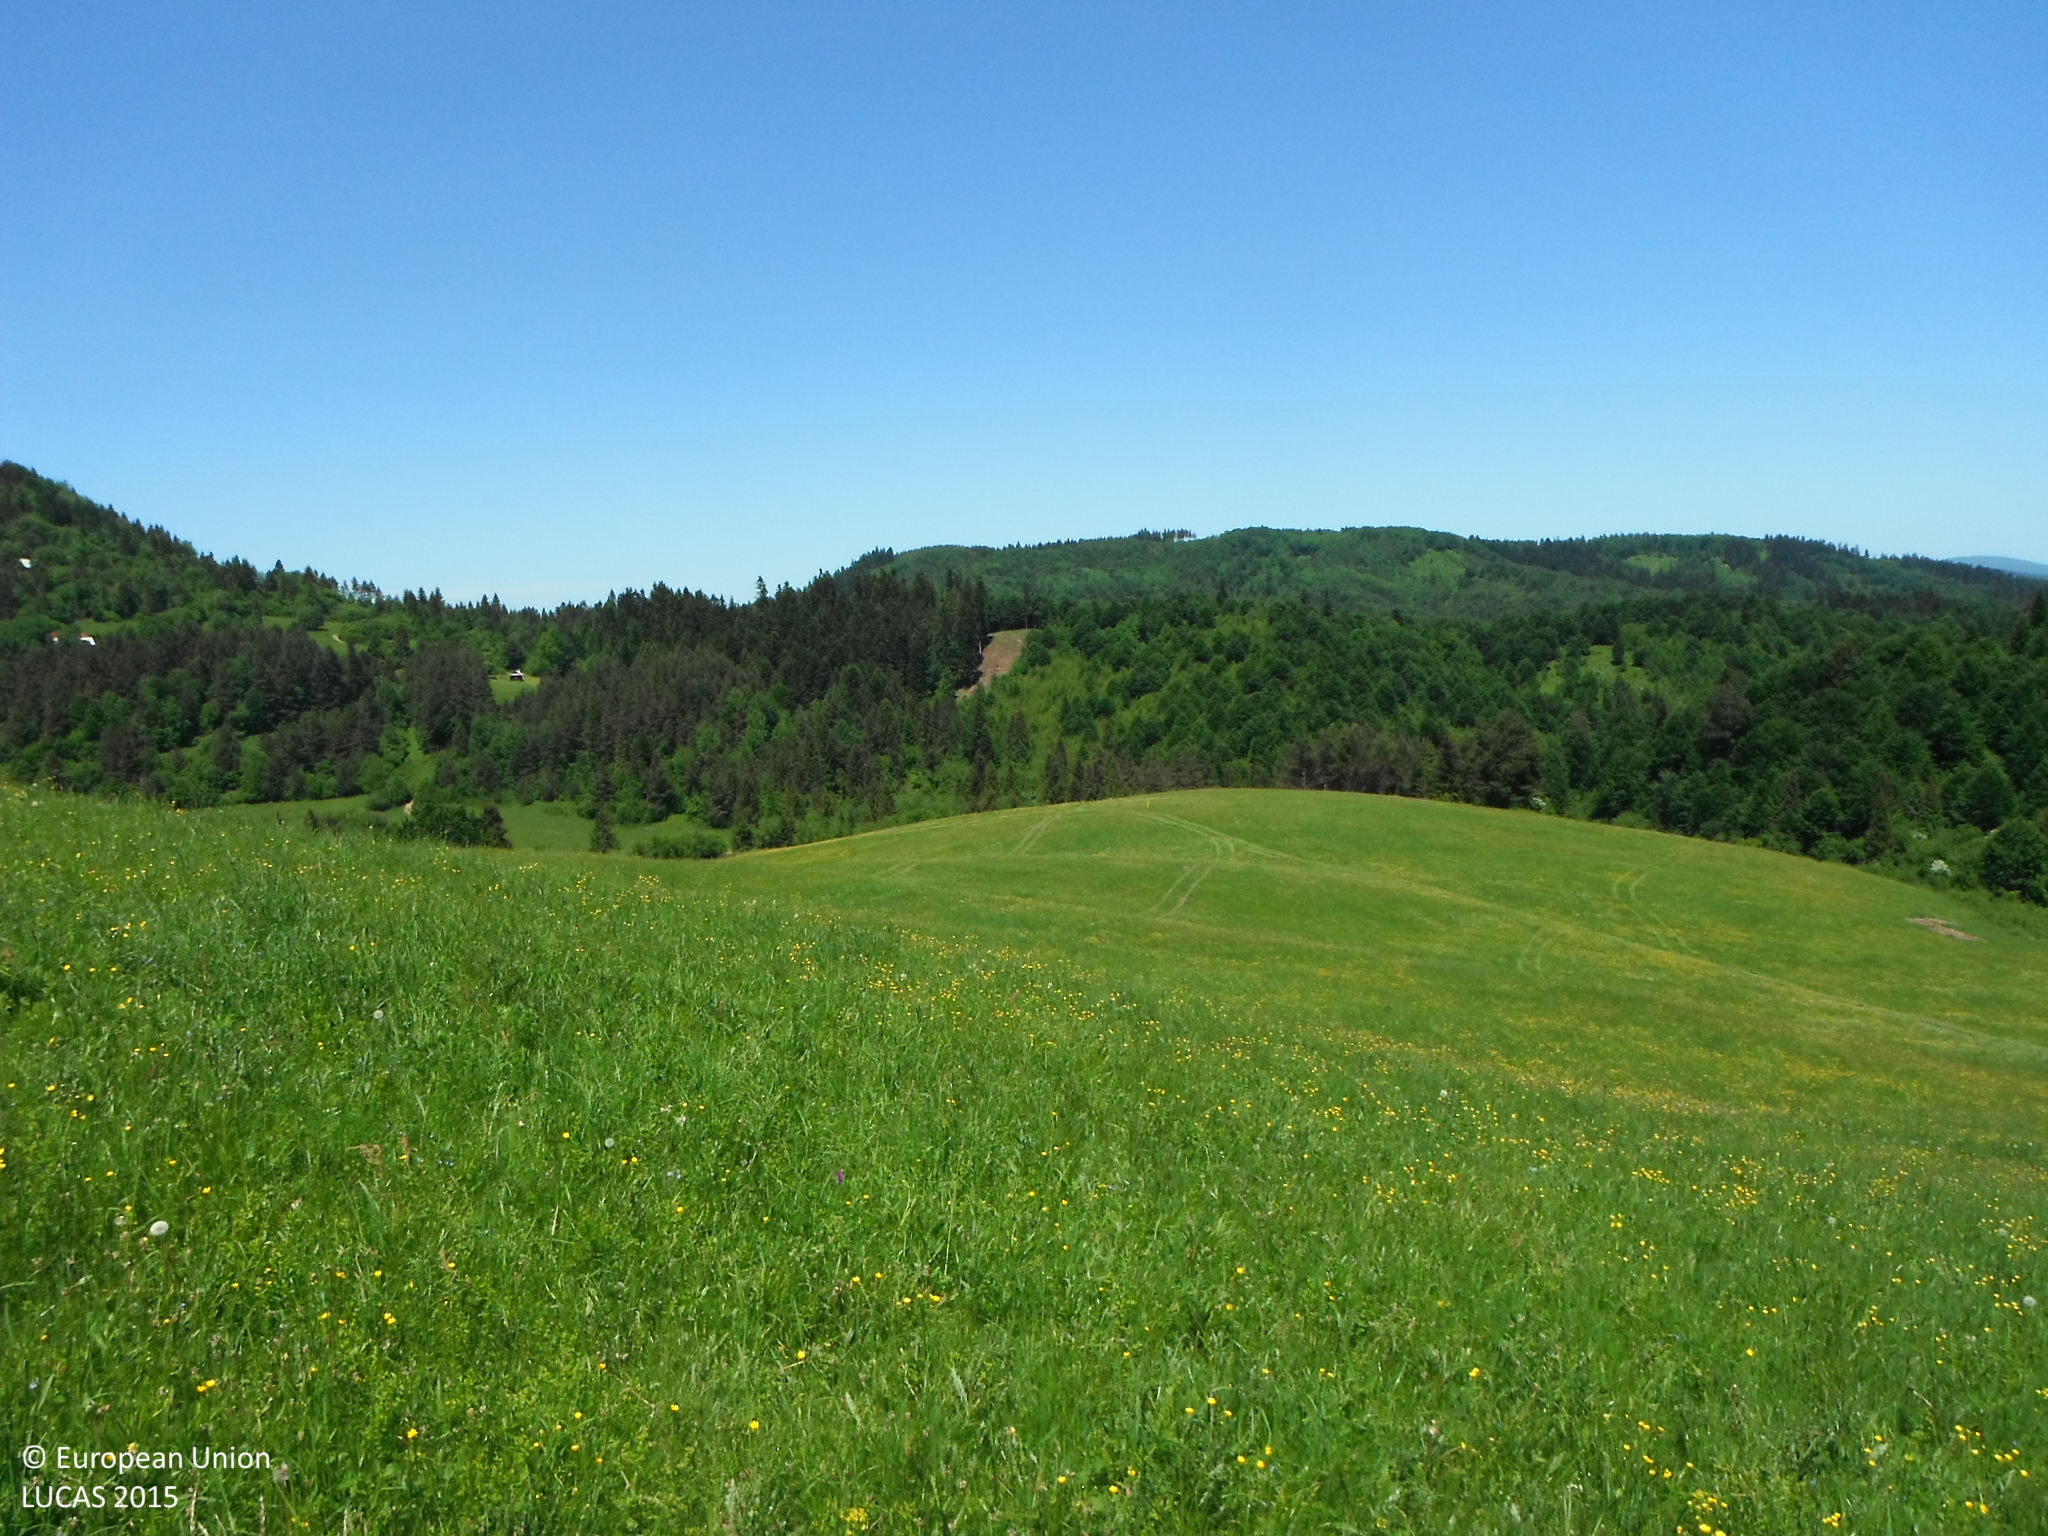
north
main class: Grassland
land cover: Grassland without tree/shrub cover
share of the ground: > 75 %
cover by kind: herbaceous plants 100 %
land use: Agriculture (excluding fallow land and kitchen gardens)
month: June
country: SK
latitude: 49.2400
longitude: 20.7389
